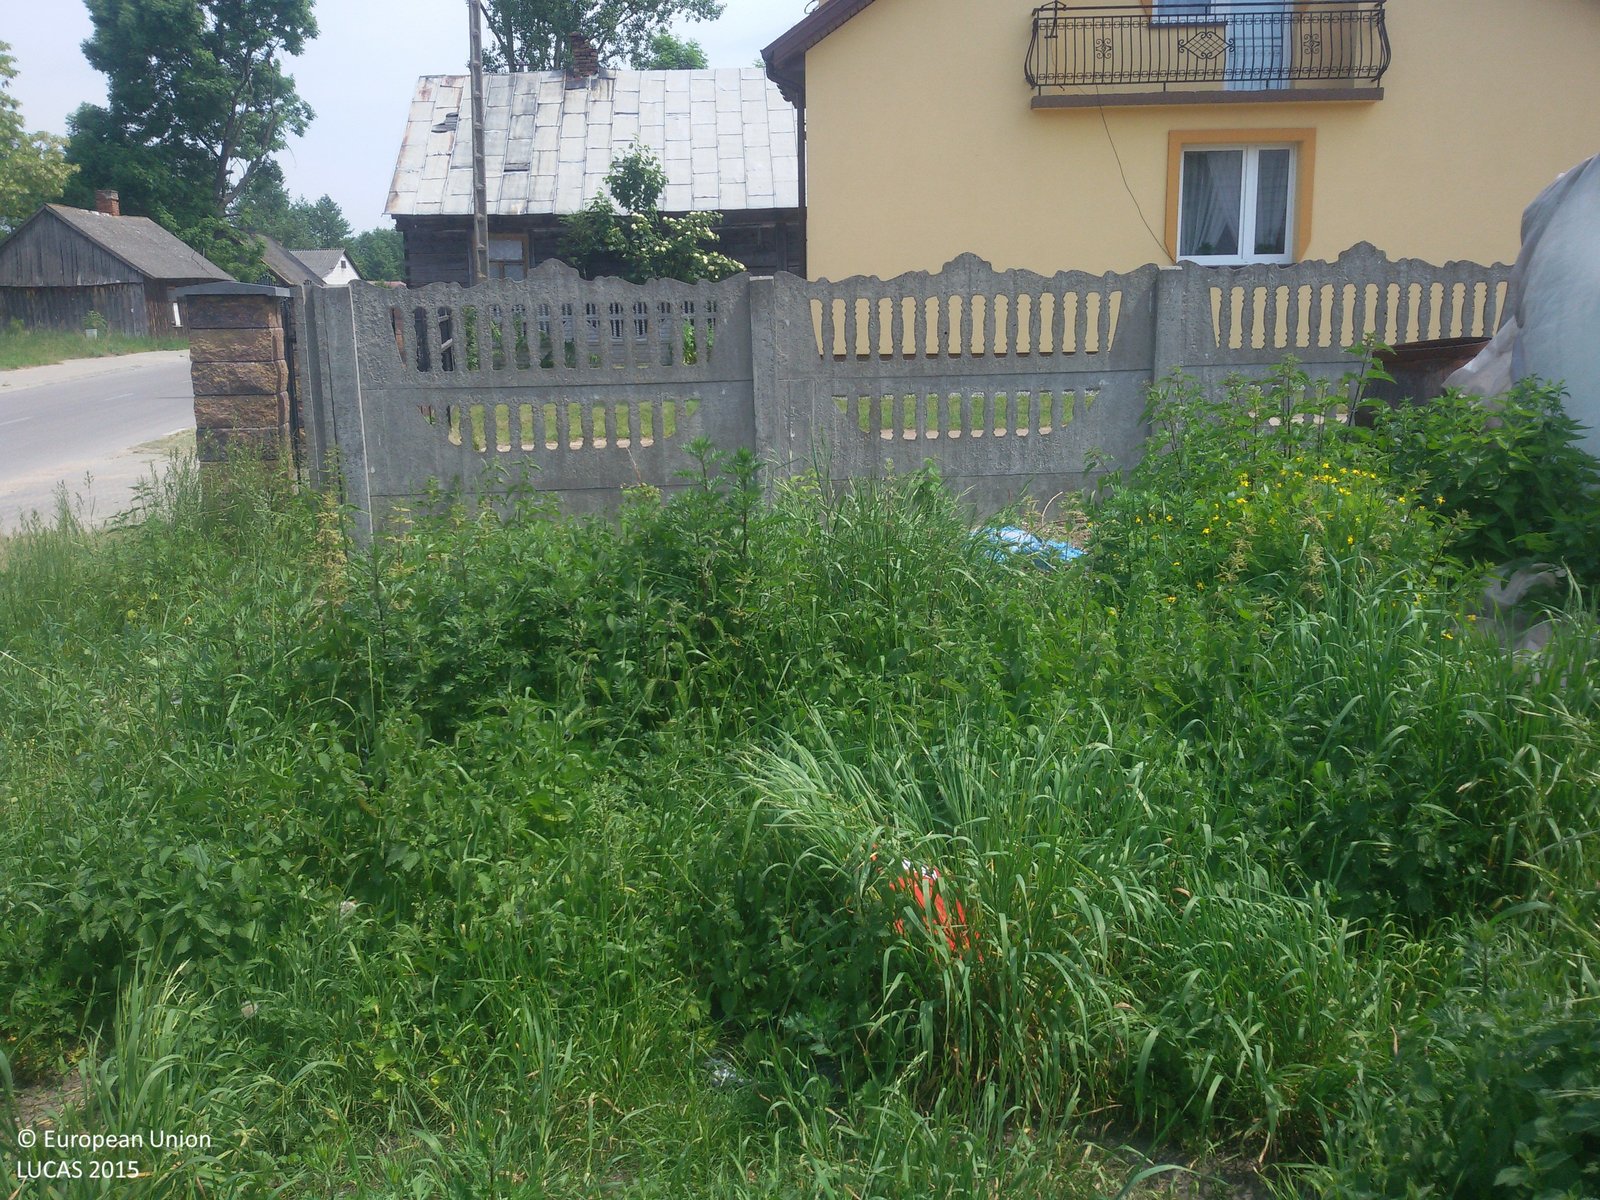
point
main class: Grassland
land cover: Spontaneously vegetated surfaces
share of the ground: > 75 %
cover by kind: herbaceous plants 100 %
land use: Abandoned areas
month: June
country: PL
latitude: 51.5506
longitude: 20.6690
